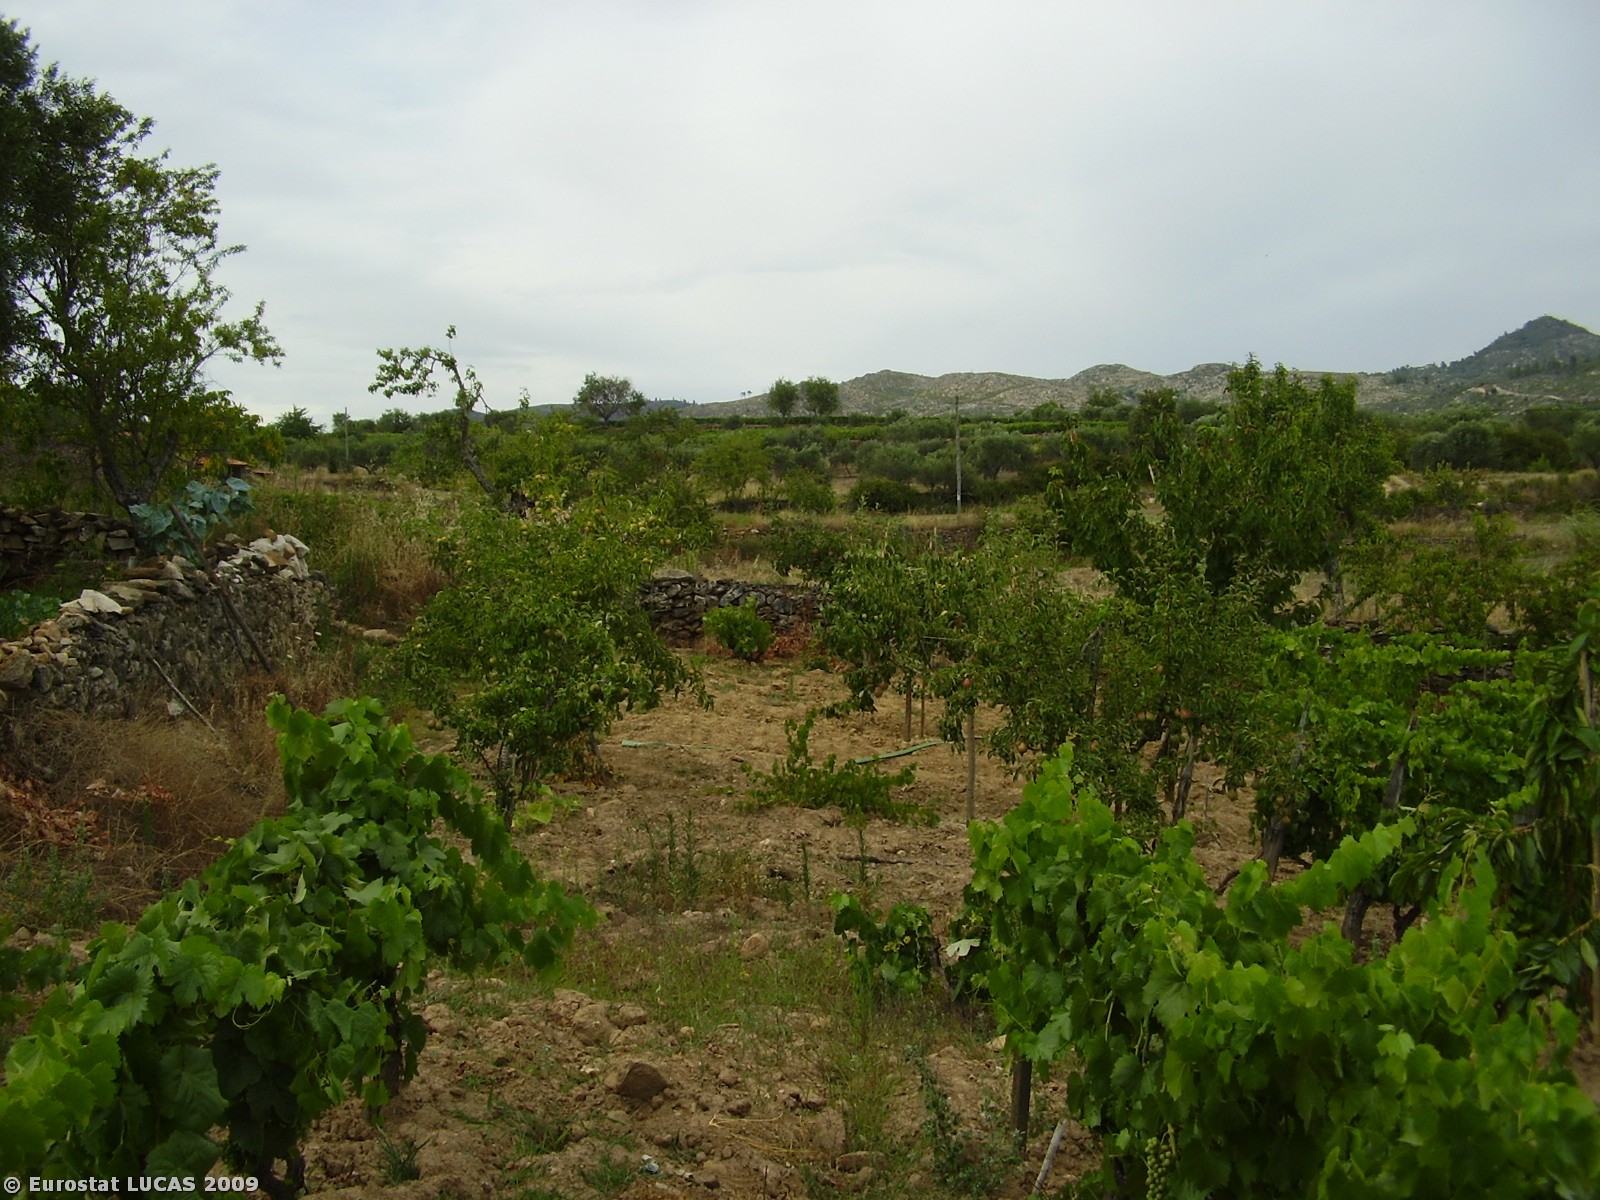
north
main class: Cropland
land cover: Vineyards
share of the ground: < 10 %
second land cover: Spontaneously vegetated surfaces
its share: < 10 %
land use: Agriculture (excluding fallow land and kitchen gardens)
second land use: Unused
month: July
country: PT
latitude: 41.2563
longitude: -7.4393
